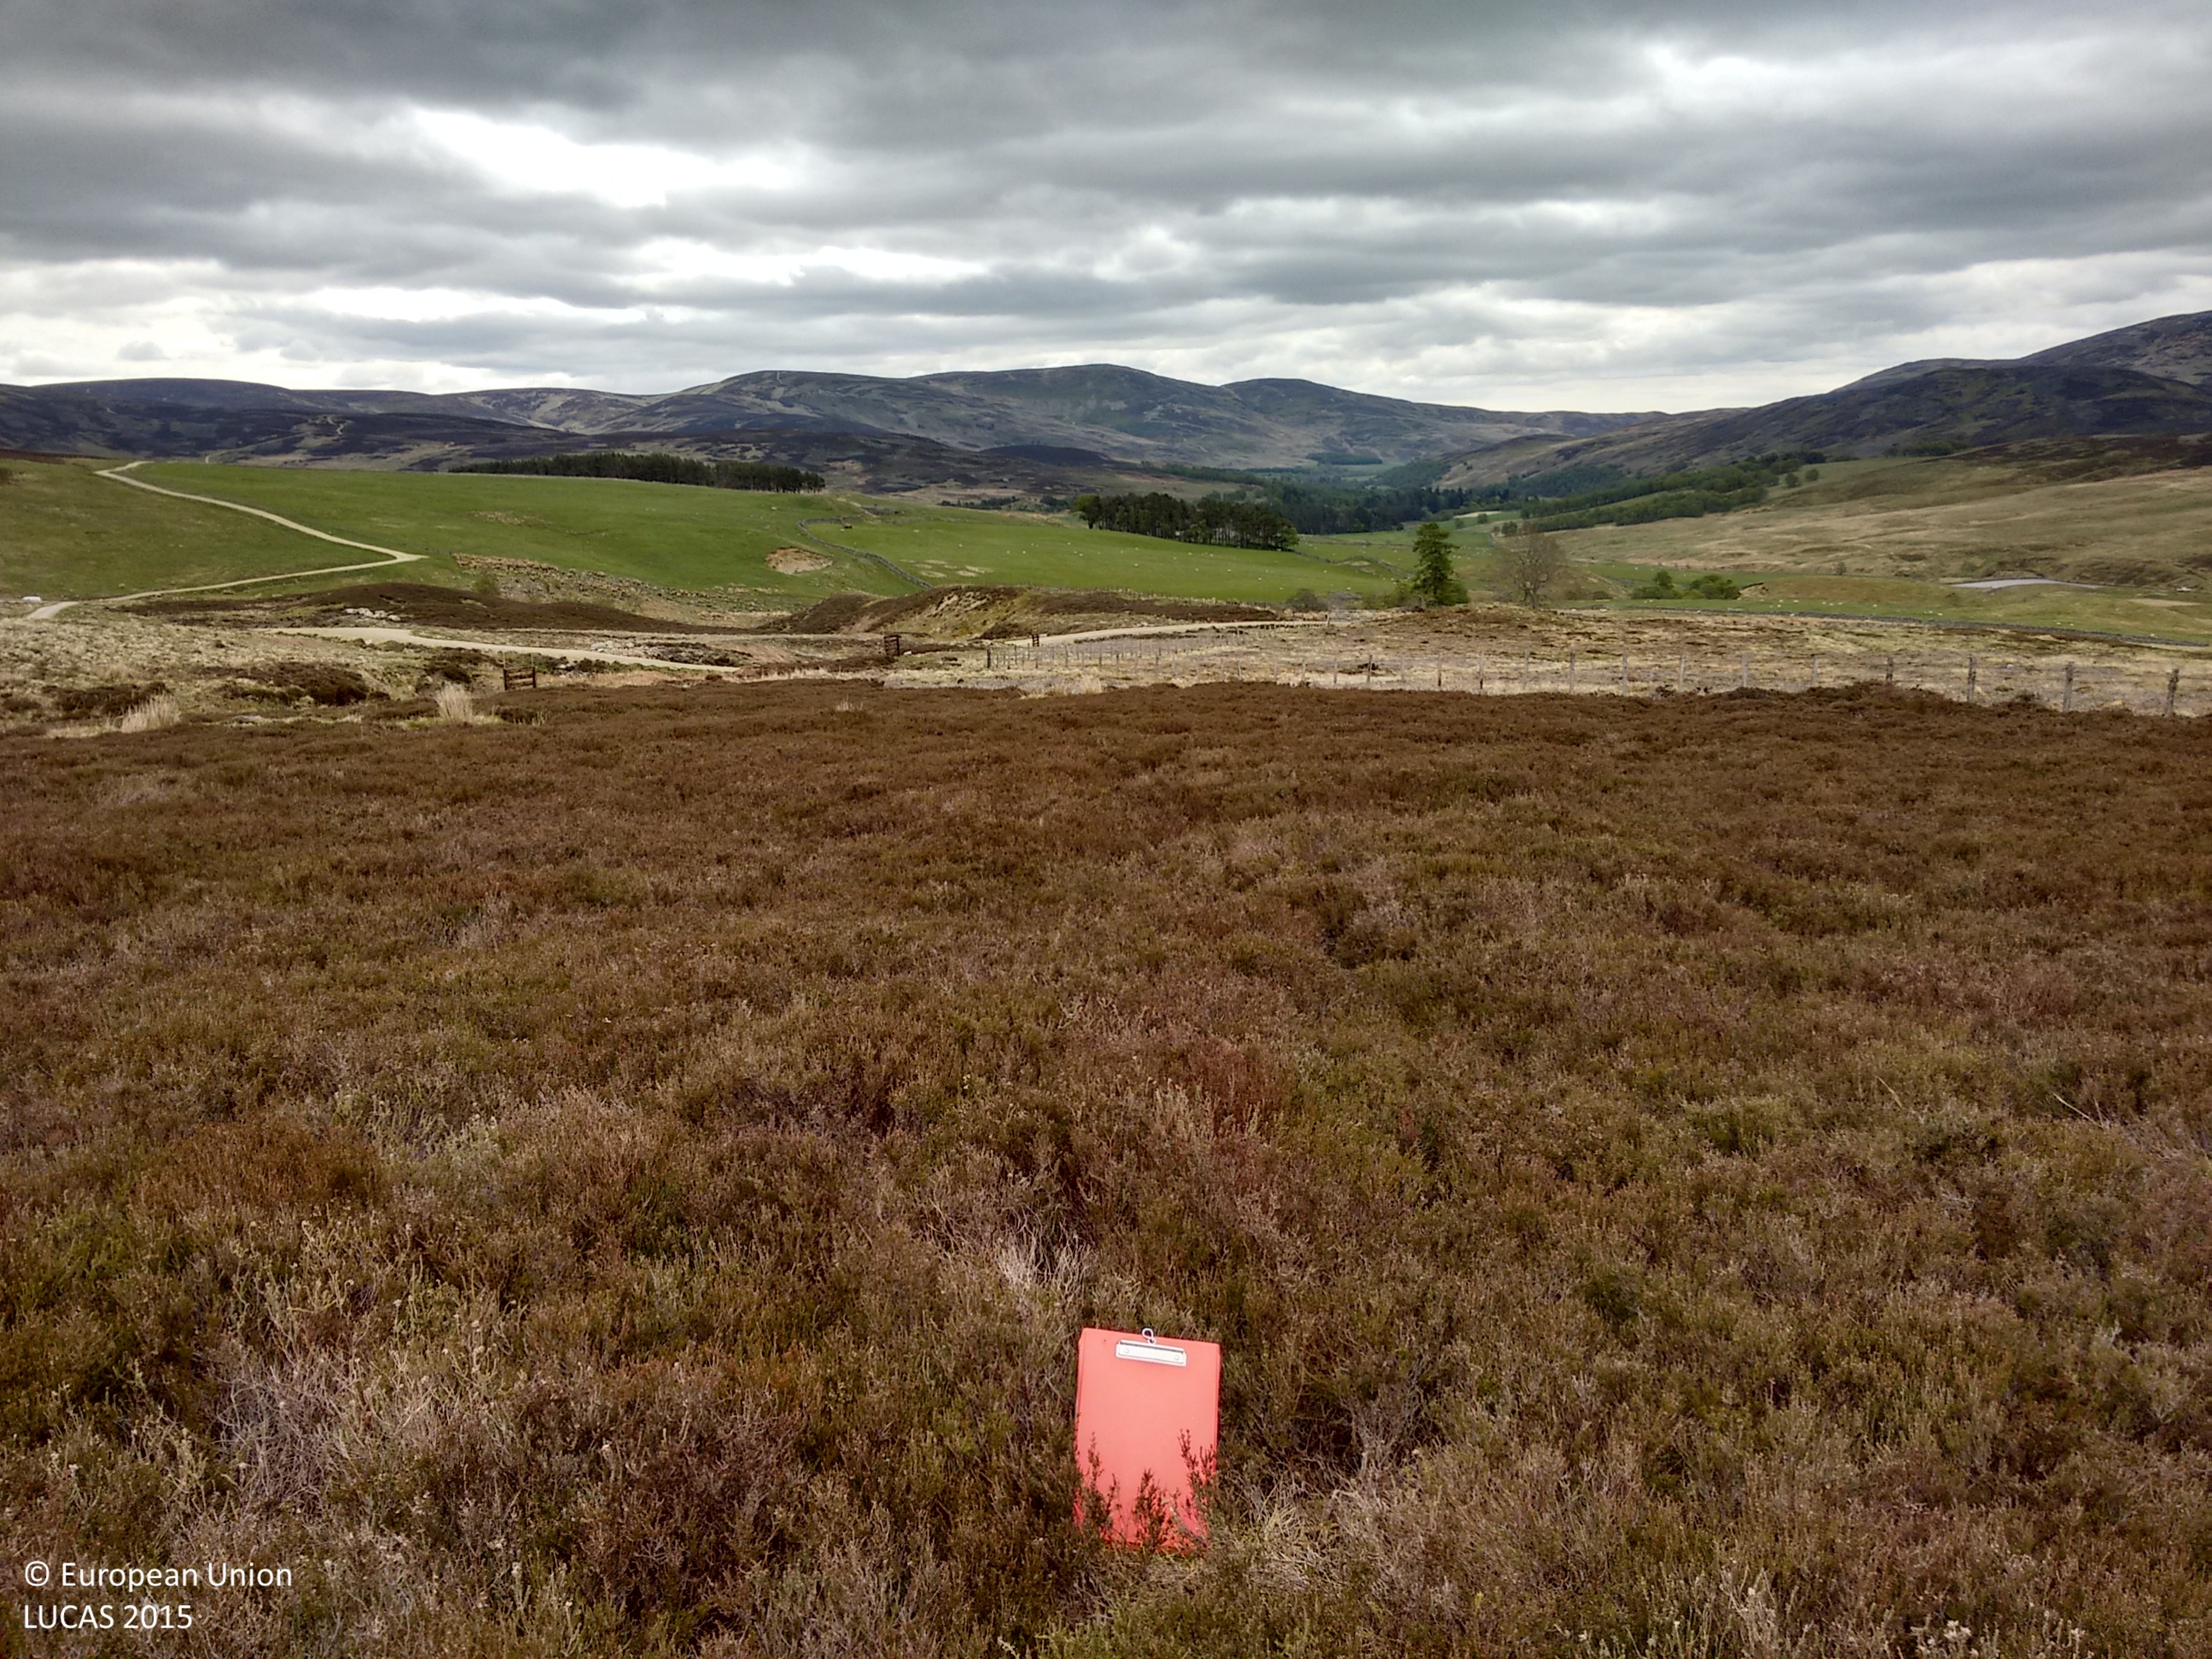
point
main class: Shrubland
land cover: Shrubland without tree cover
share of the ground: > 75 %
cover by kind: shrubs 95 %, herbaceous plants 5 %
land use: Semi-natural and natural areas not in use
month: May
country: GB
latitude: 56.9120
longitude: -2.7889
